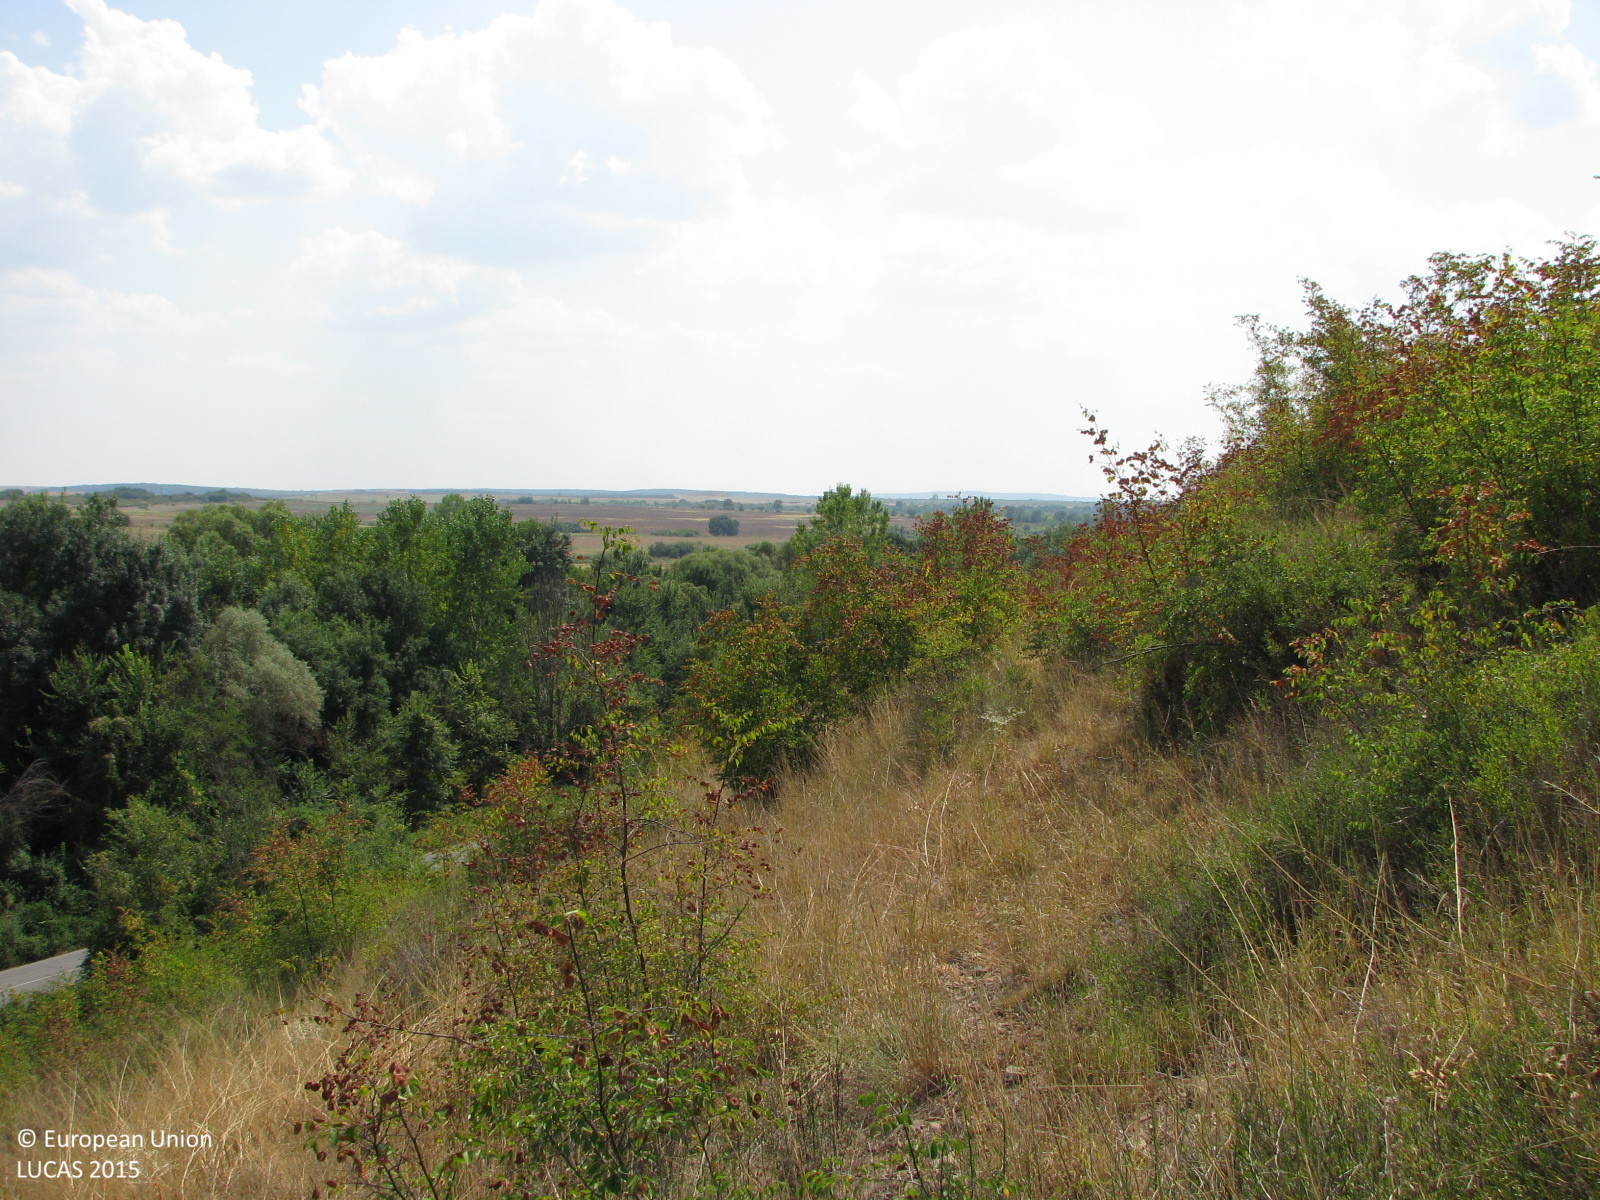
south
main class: Shrubland
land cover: Shrubland with sparse tree cover
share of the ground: 50 - 75 %
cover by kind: shrubs 50 %, herbaceous plants 45 %, broadleaved forest trees 5 %
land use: Agriculture (excluding fallow land and kitchen gardens)
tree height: < 5 m
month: August
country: BG
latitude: 42.1777
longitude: 26.6907
